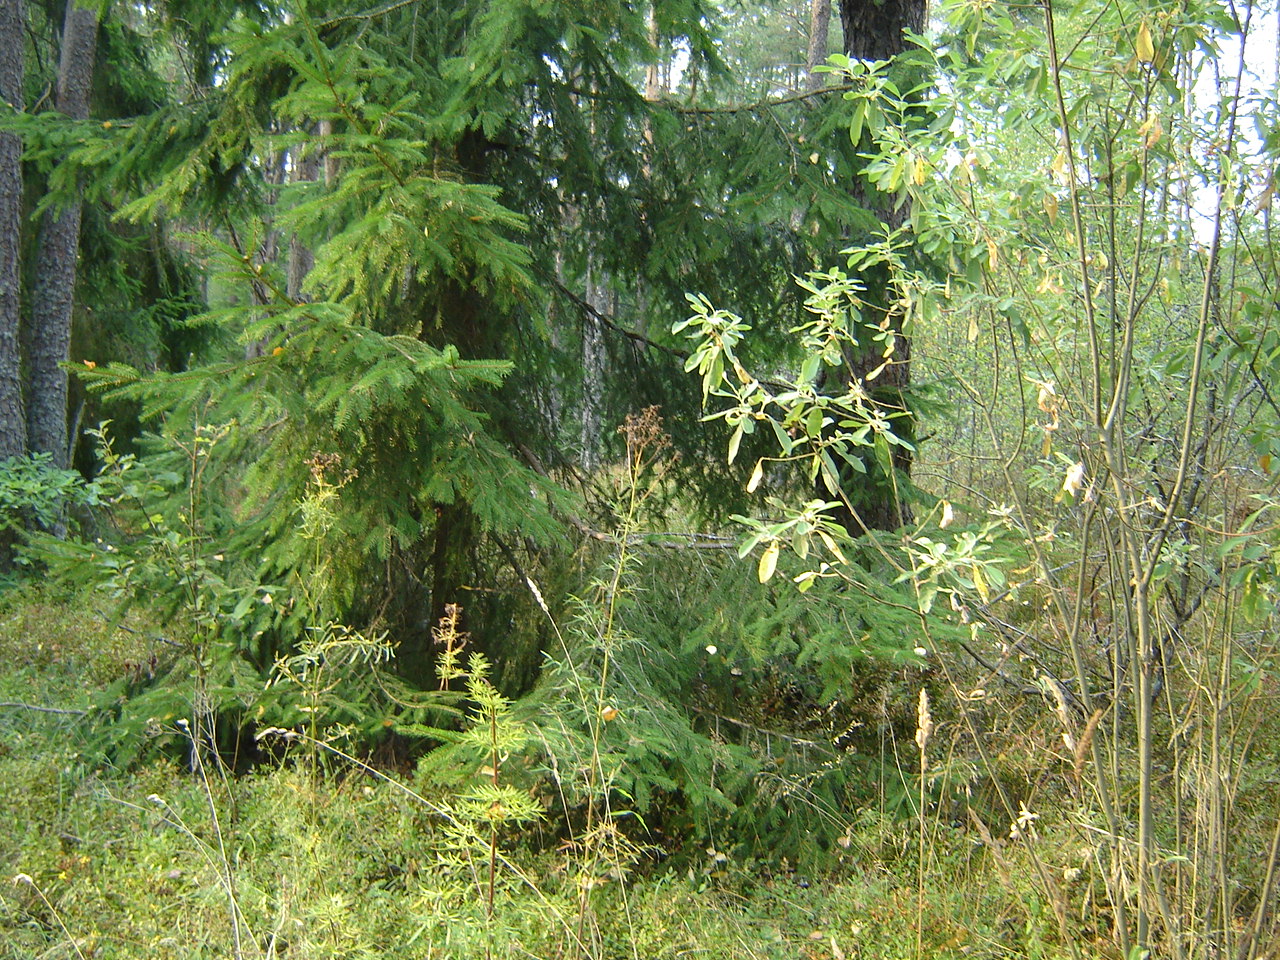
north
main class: Woodland
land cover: Pine dominated mixed woodland
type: hemiboreal forest and nemoral coniferous forest and mixed broadleaved-coniferous forest
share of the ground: > 75 %
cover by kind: coniferous forest trees 55 %, broadleaved forest trees 30 %, shrubs 5 %, herbaceous plants 5 %, lichens and mosses 5 %
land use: Forestry
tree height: > 5 m
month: September
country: LT
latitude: 54.4883
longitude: 24.8852
